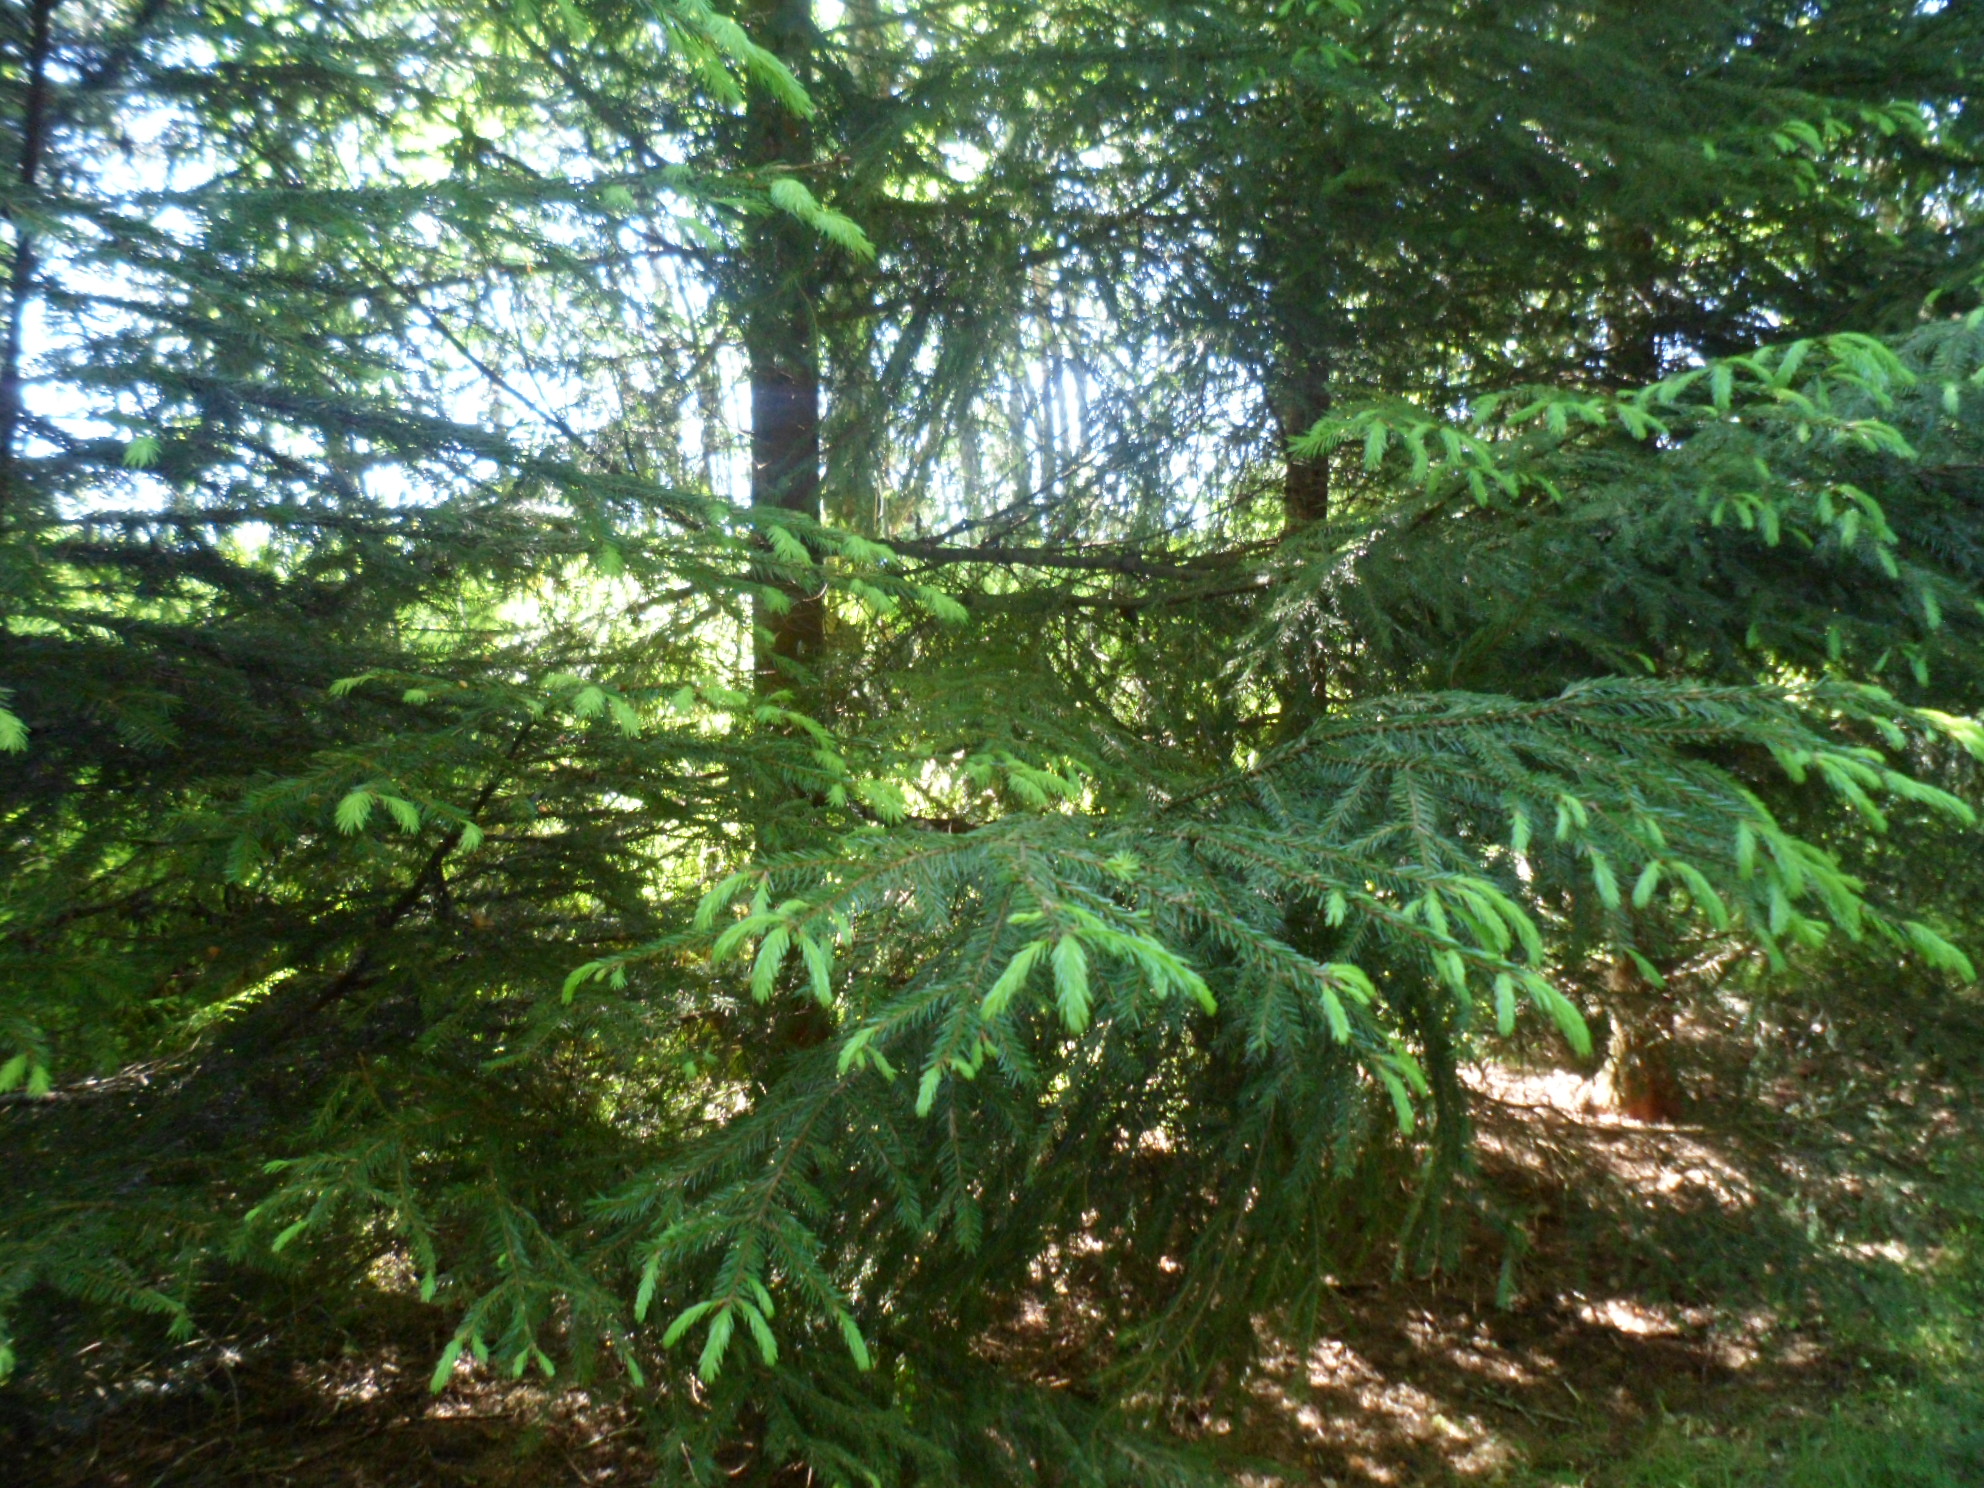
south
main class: Woodland
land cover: Spruce dominated coniferous woodland
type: boreal forest
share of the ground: > 75 %
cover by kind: coniferous forest trees 75 %, herbaceous plants 15 %, lichens and mosses 10 %
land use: Forestry
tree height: > 5 m
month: July
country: SE
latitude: 57.4534
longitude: 14.6790
